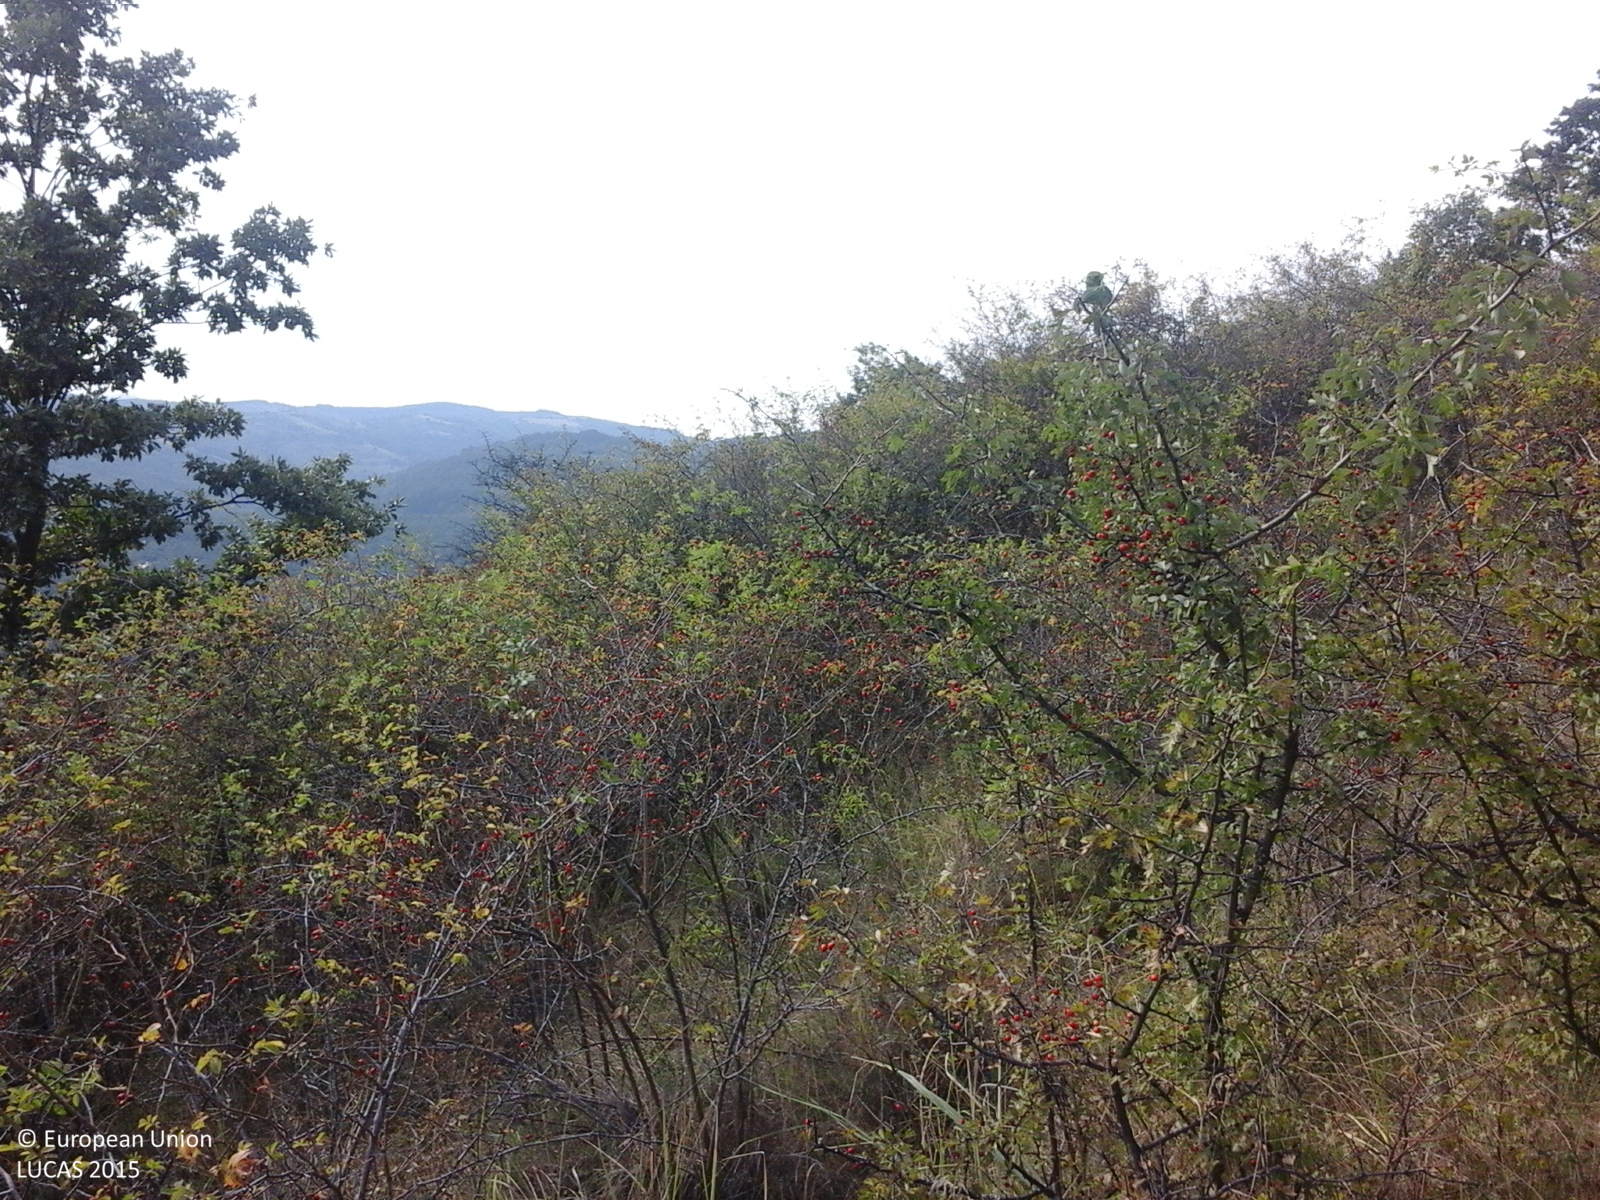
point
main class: Shrubland
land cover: Shrubland without tree cover
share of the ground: > 75 %
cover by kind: shrubs 100 %
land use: Semi-natural and natural areas not in use
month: September
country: RO
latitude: 47.2074
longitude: 23.6332
